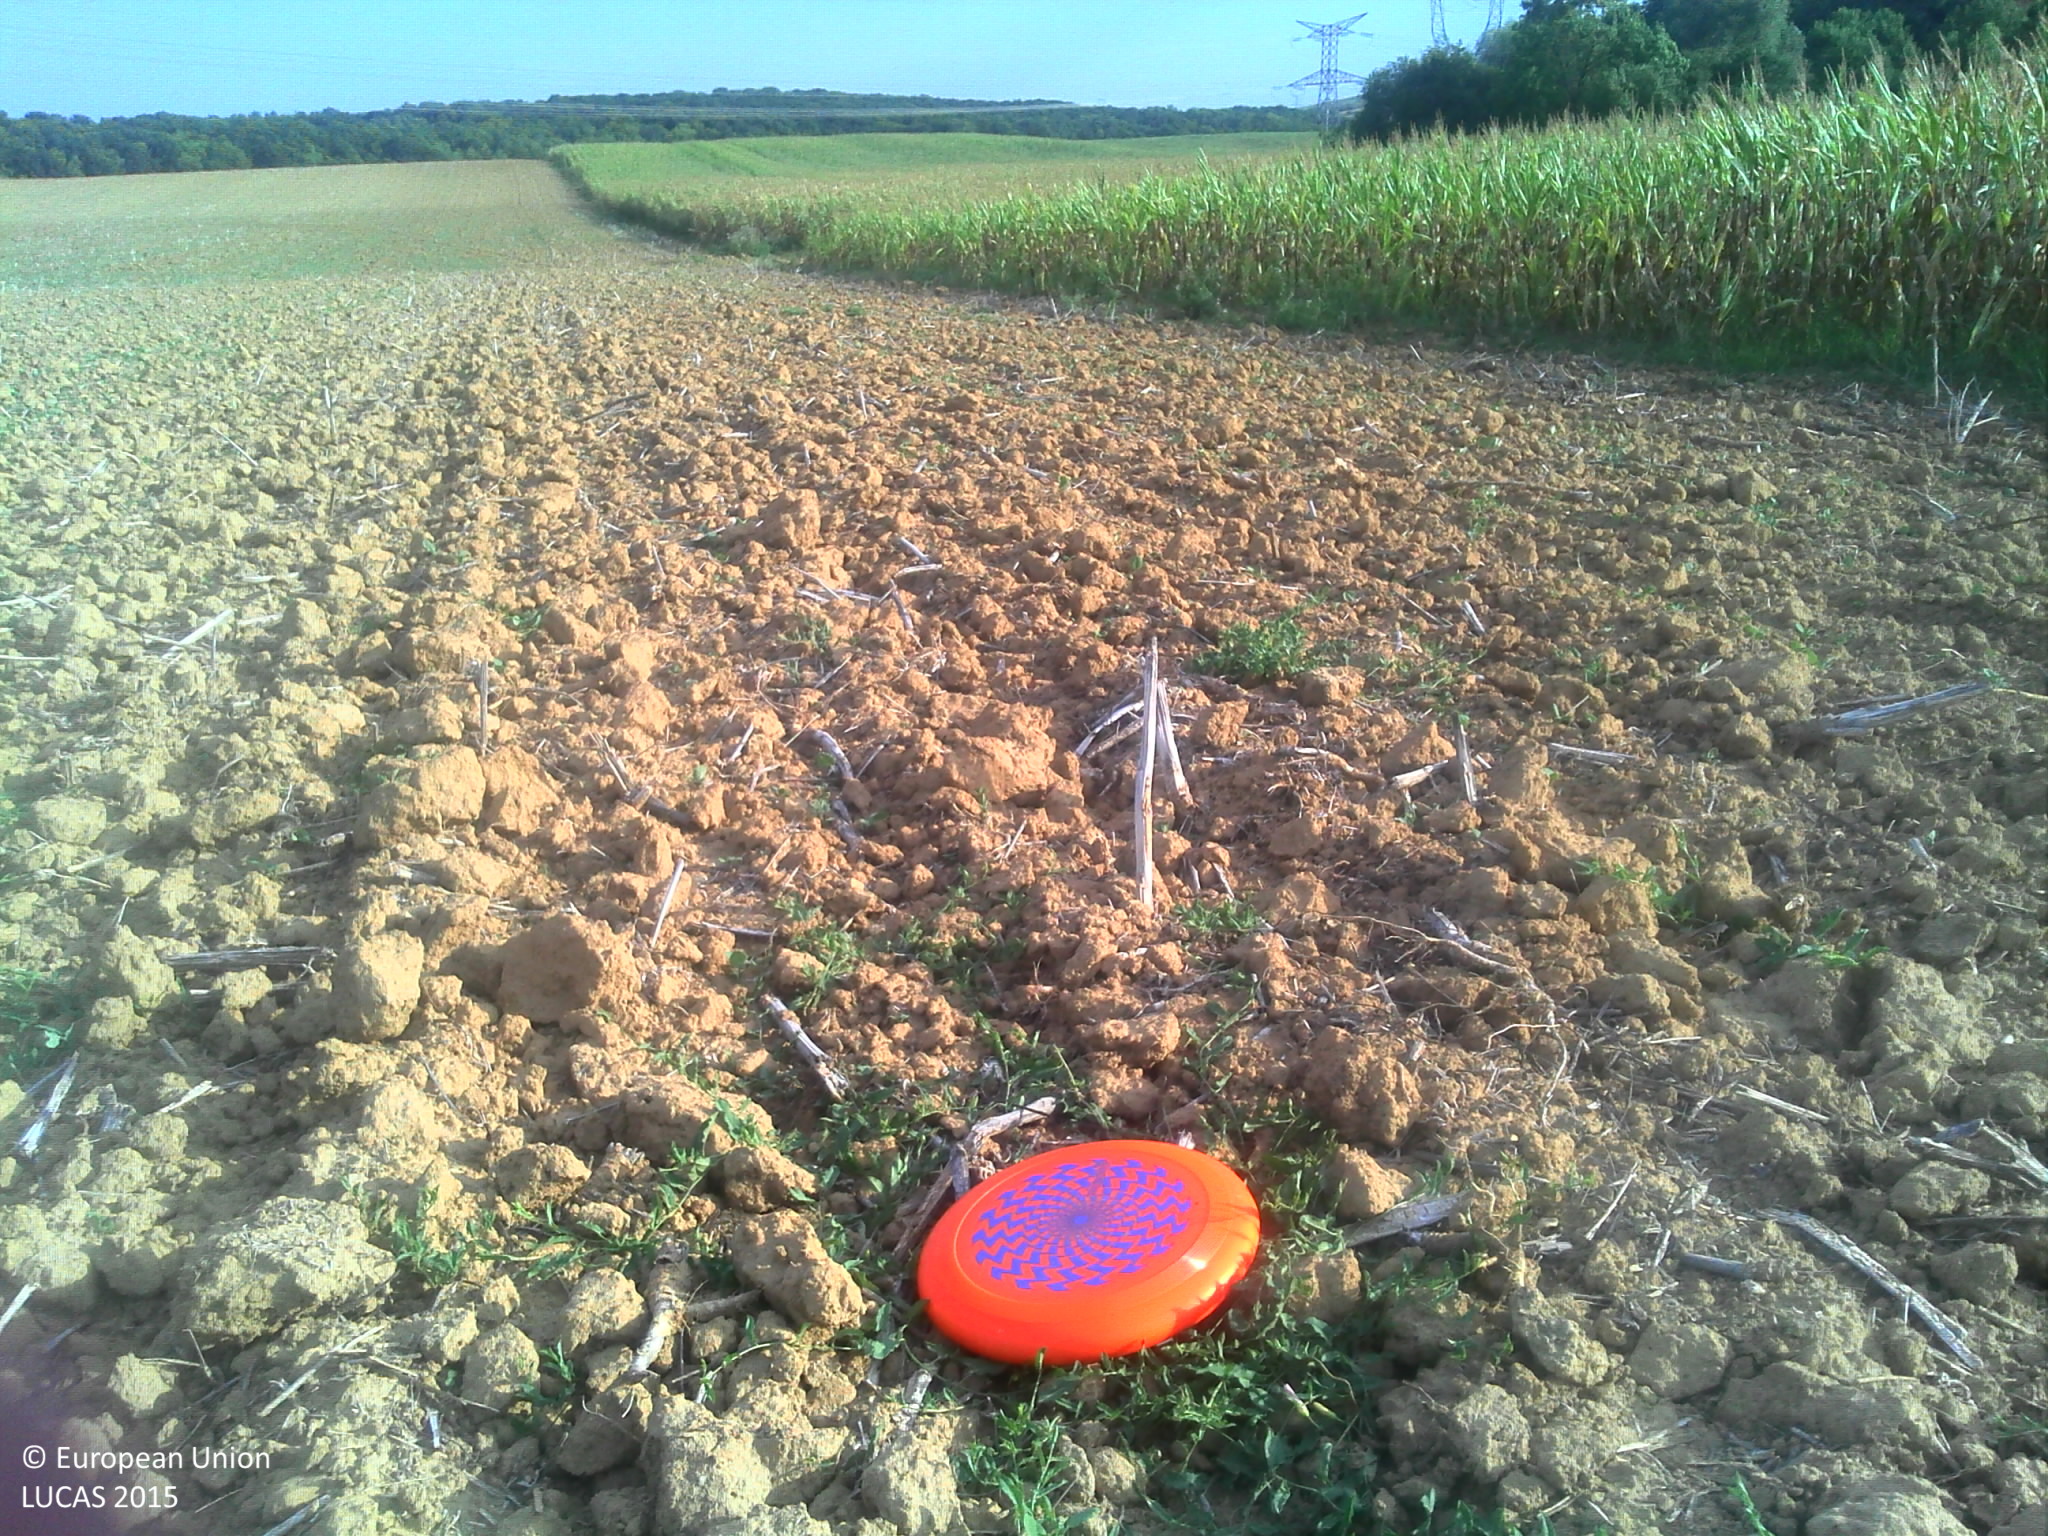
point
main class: Cropland
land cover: Rape and turnip rape
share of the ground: < 10 %
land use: Agriculture (excluding fallow land and kitchen gardens)
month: August
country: FR
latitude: 48.8765
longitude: 6.1411
